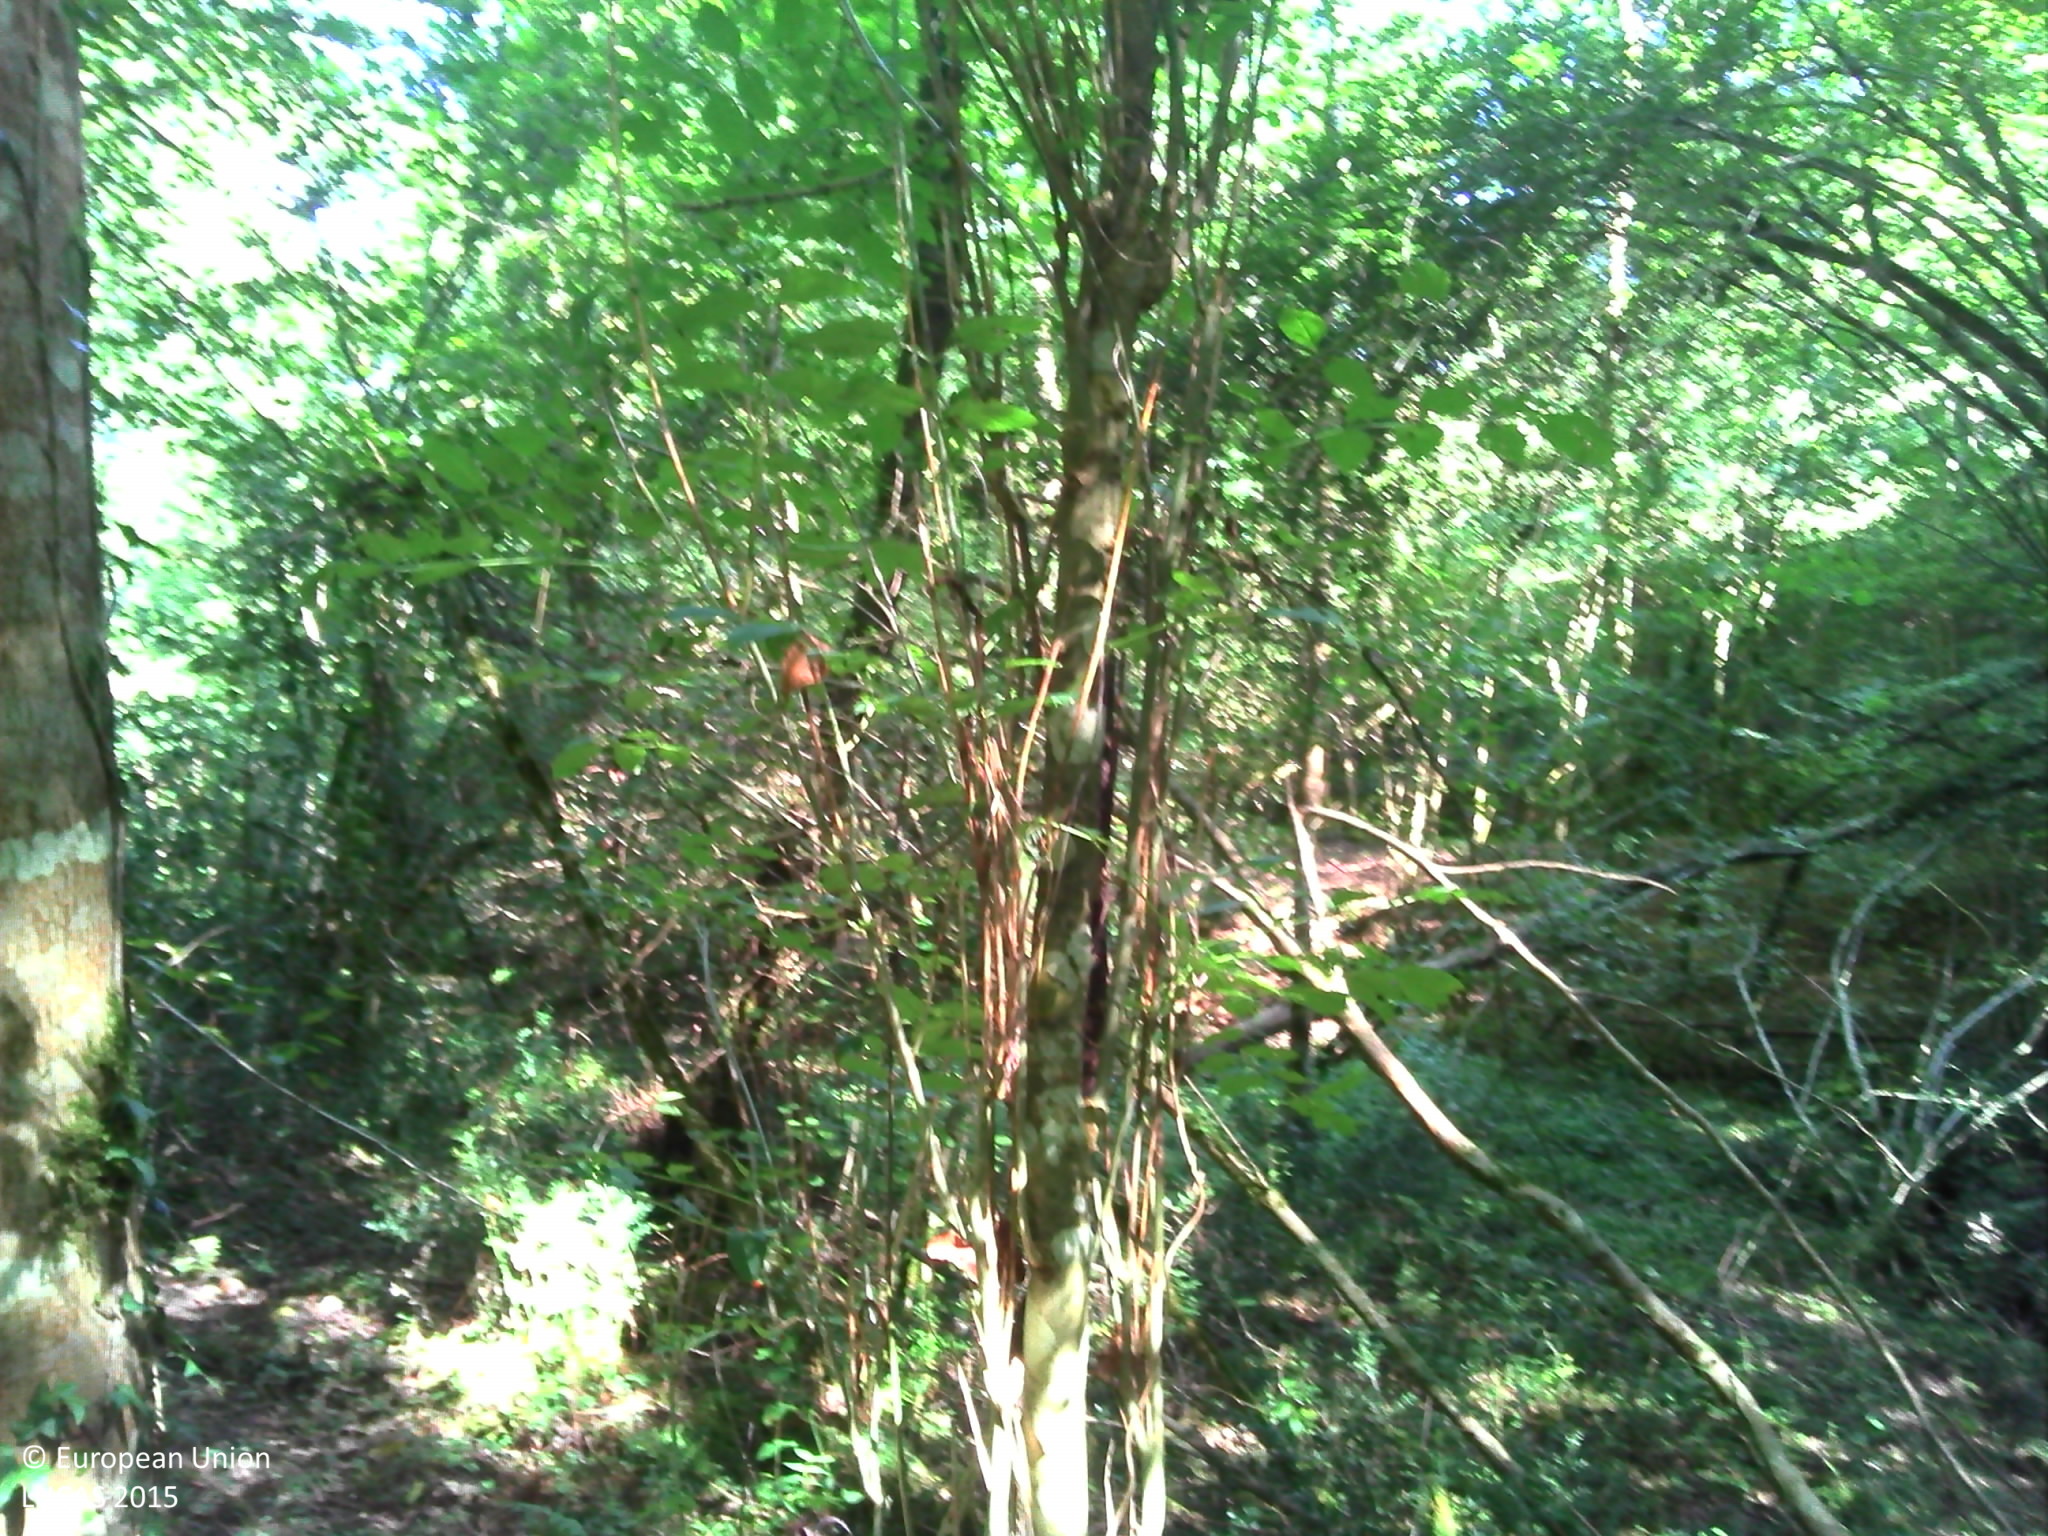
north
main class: Woodland
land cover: Broadleaved woodland
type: mesophytic deciduous forest
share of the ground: 50 - 75 %
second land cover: Spontaneously vegetated surfaces
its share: 25 - 50 %
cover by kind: broadleaved forest trees 70 %, herbaceous plants 15 %, shrubs 10 %, lichens and mosses 5 %
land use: Agriculture (excluding fallow land and kitchen gardens)
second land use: Forestry
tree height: > 5 m
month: September
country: FR
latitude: 43.2837
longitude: -1.0669
